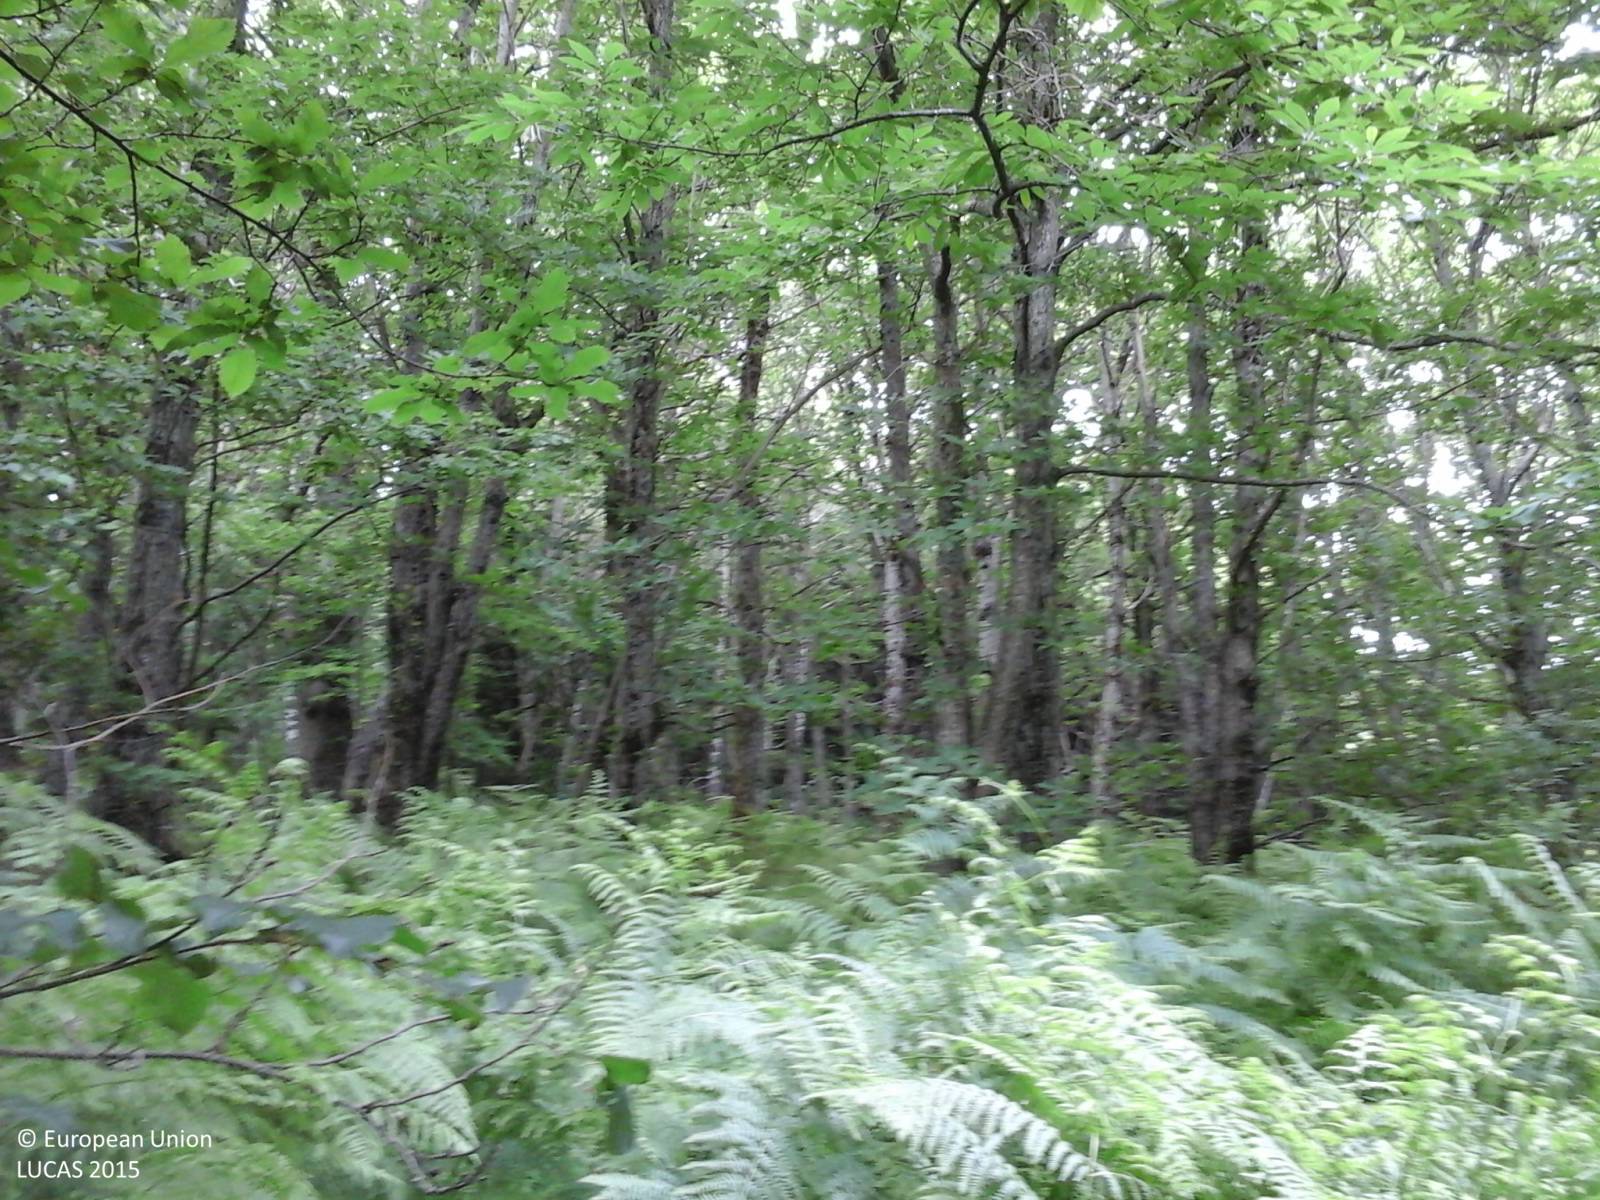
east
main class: Woodland
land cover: Broadleaved woodland
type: thermophilous deciduous forest
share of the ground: > 75 %
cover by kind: broadleaved forest trees 100 %
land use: Forestry
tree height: > 5 m
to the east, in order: Broadleaved woodland
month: June
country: IT
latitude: 44.2599
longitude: 10.3124
